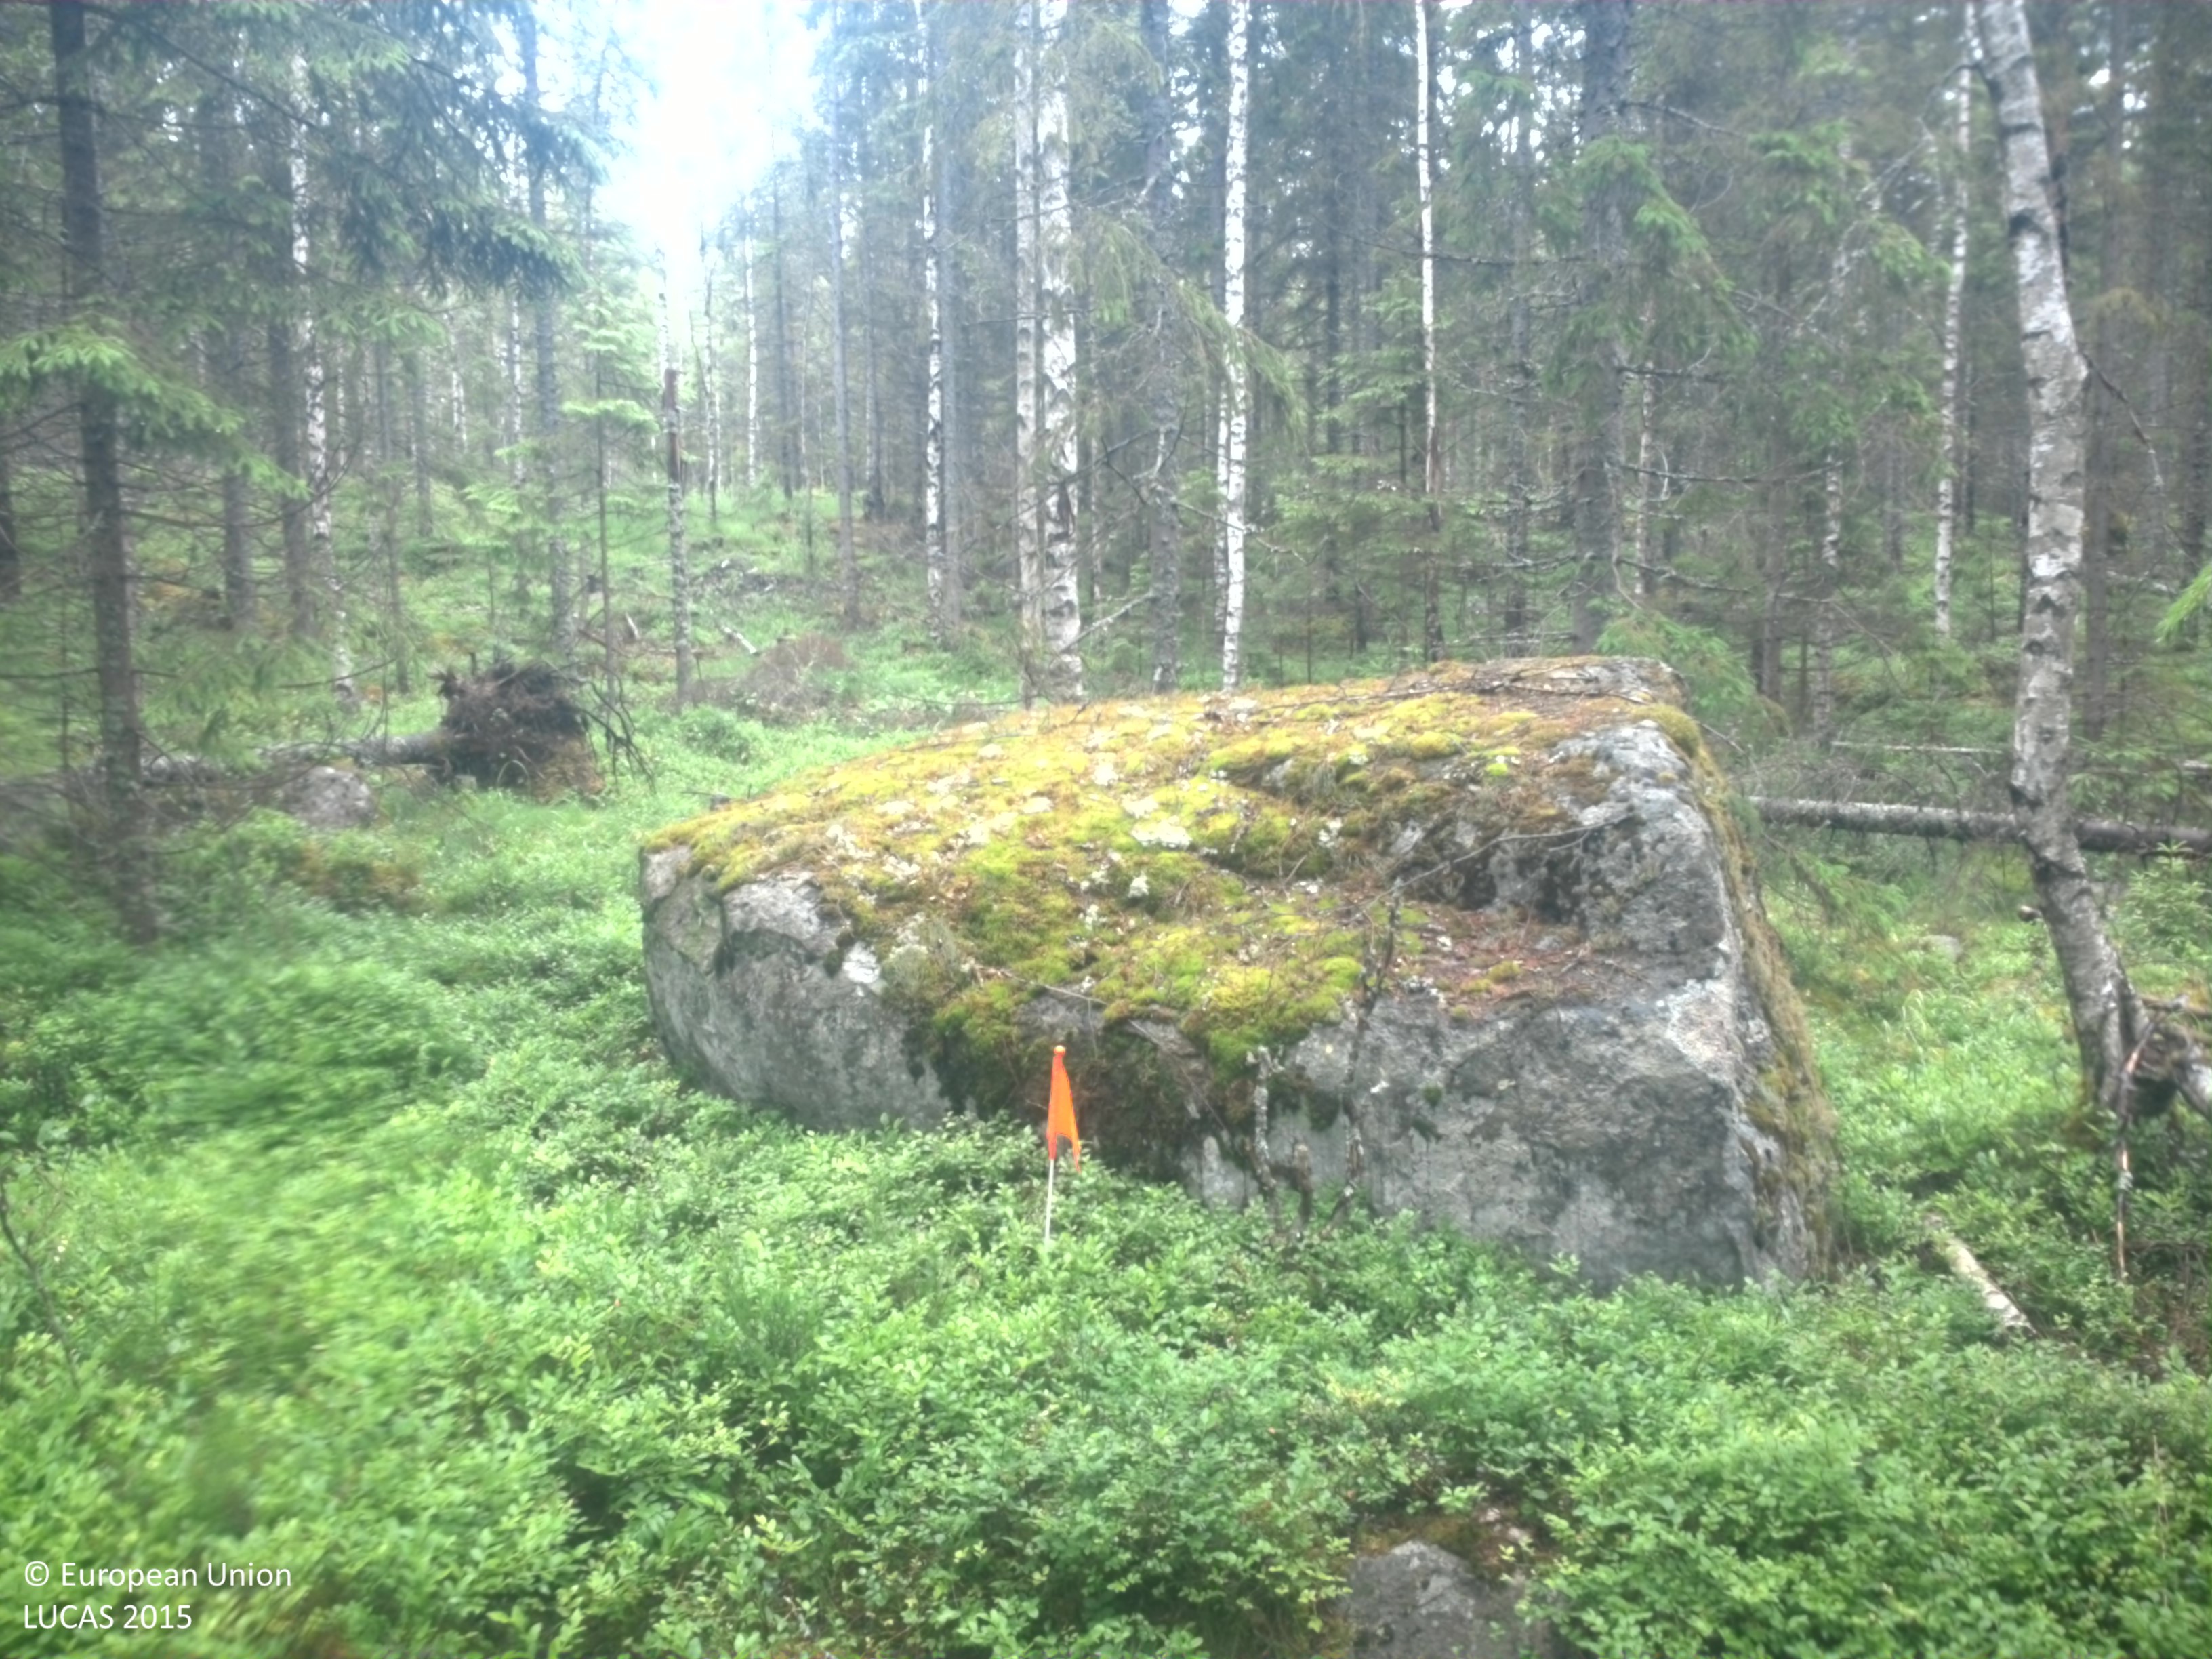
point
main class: Woodland
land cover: Spruce dominated mixed woodland
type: boreal forest
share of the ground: 50 - 75 %
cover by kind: coniferous forest trees 40 %, broadleaved forest trees 20 %, shrubs 20 %, herbaceous plants 10 %, lichens and mosses 5 %, consolidated bare surface 5 %
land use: Forestry
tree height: > 5 m
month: July
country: SE
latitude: 59.5870
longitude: 14.4713
